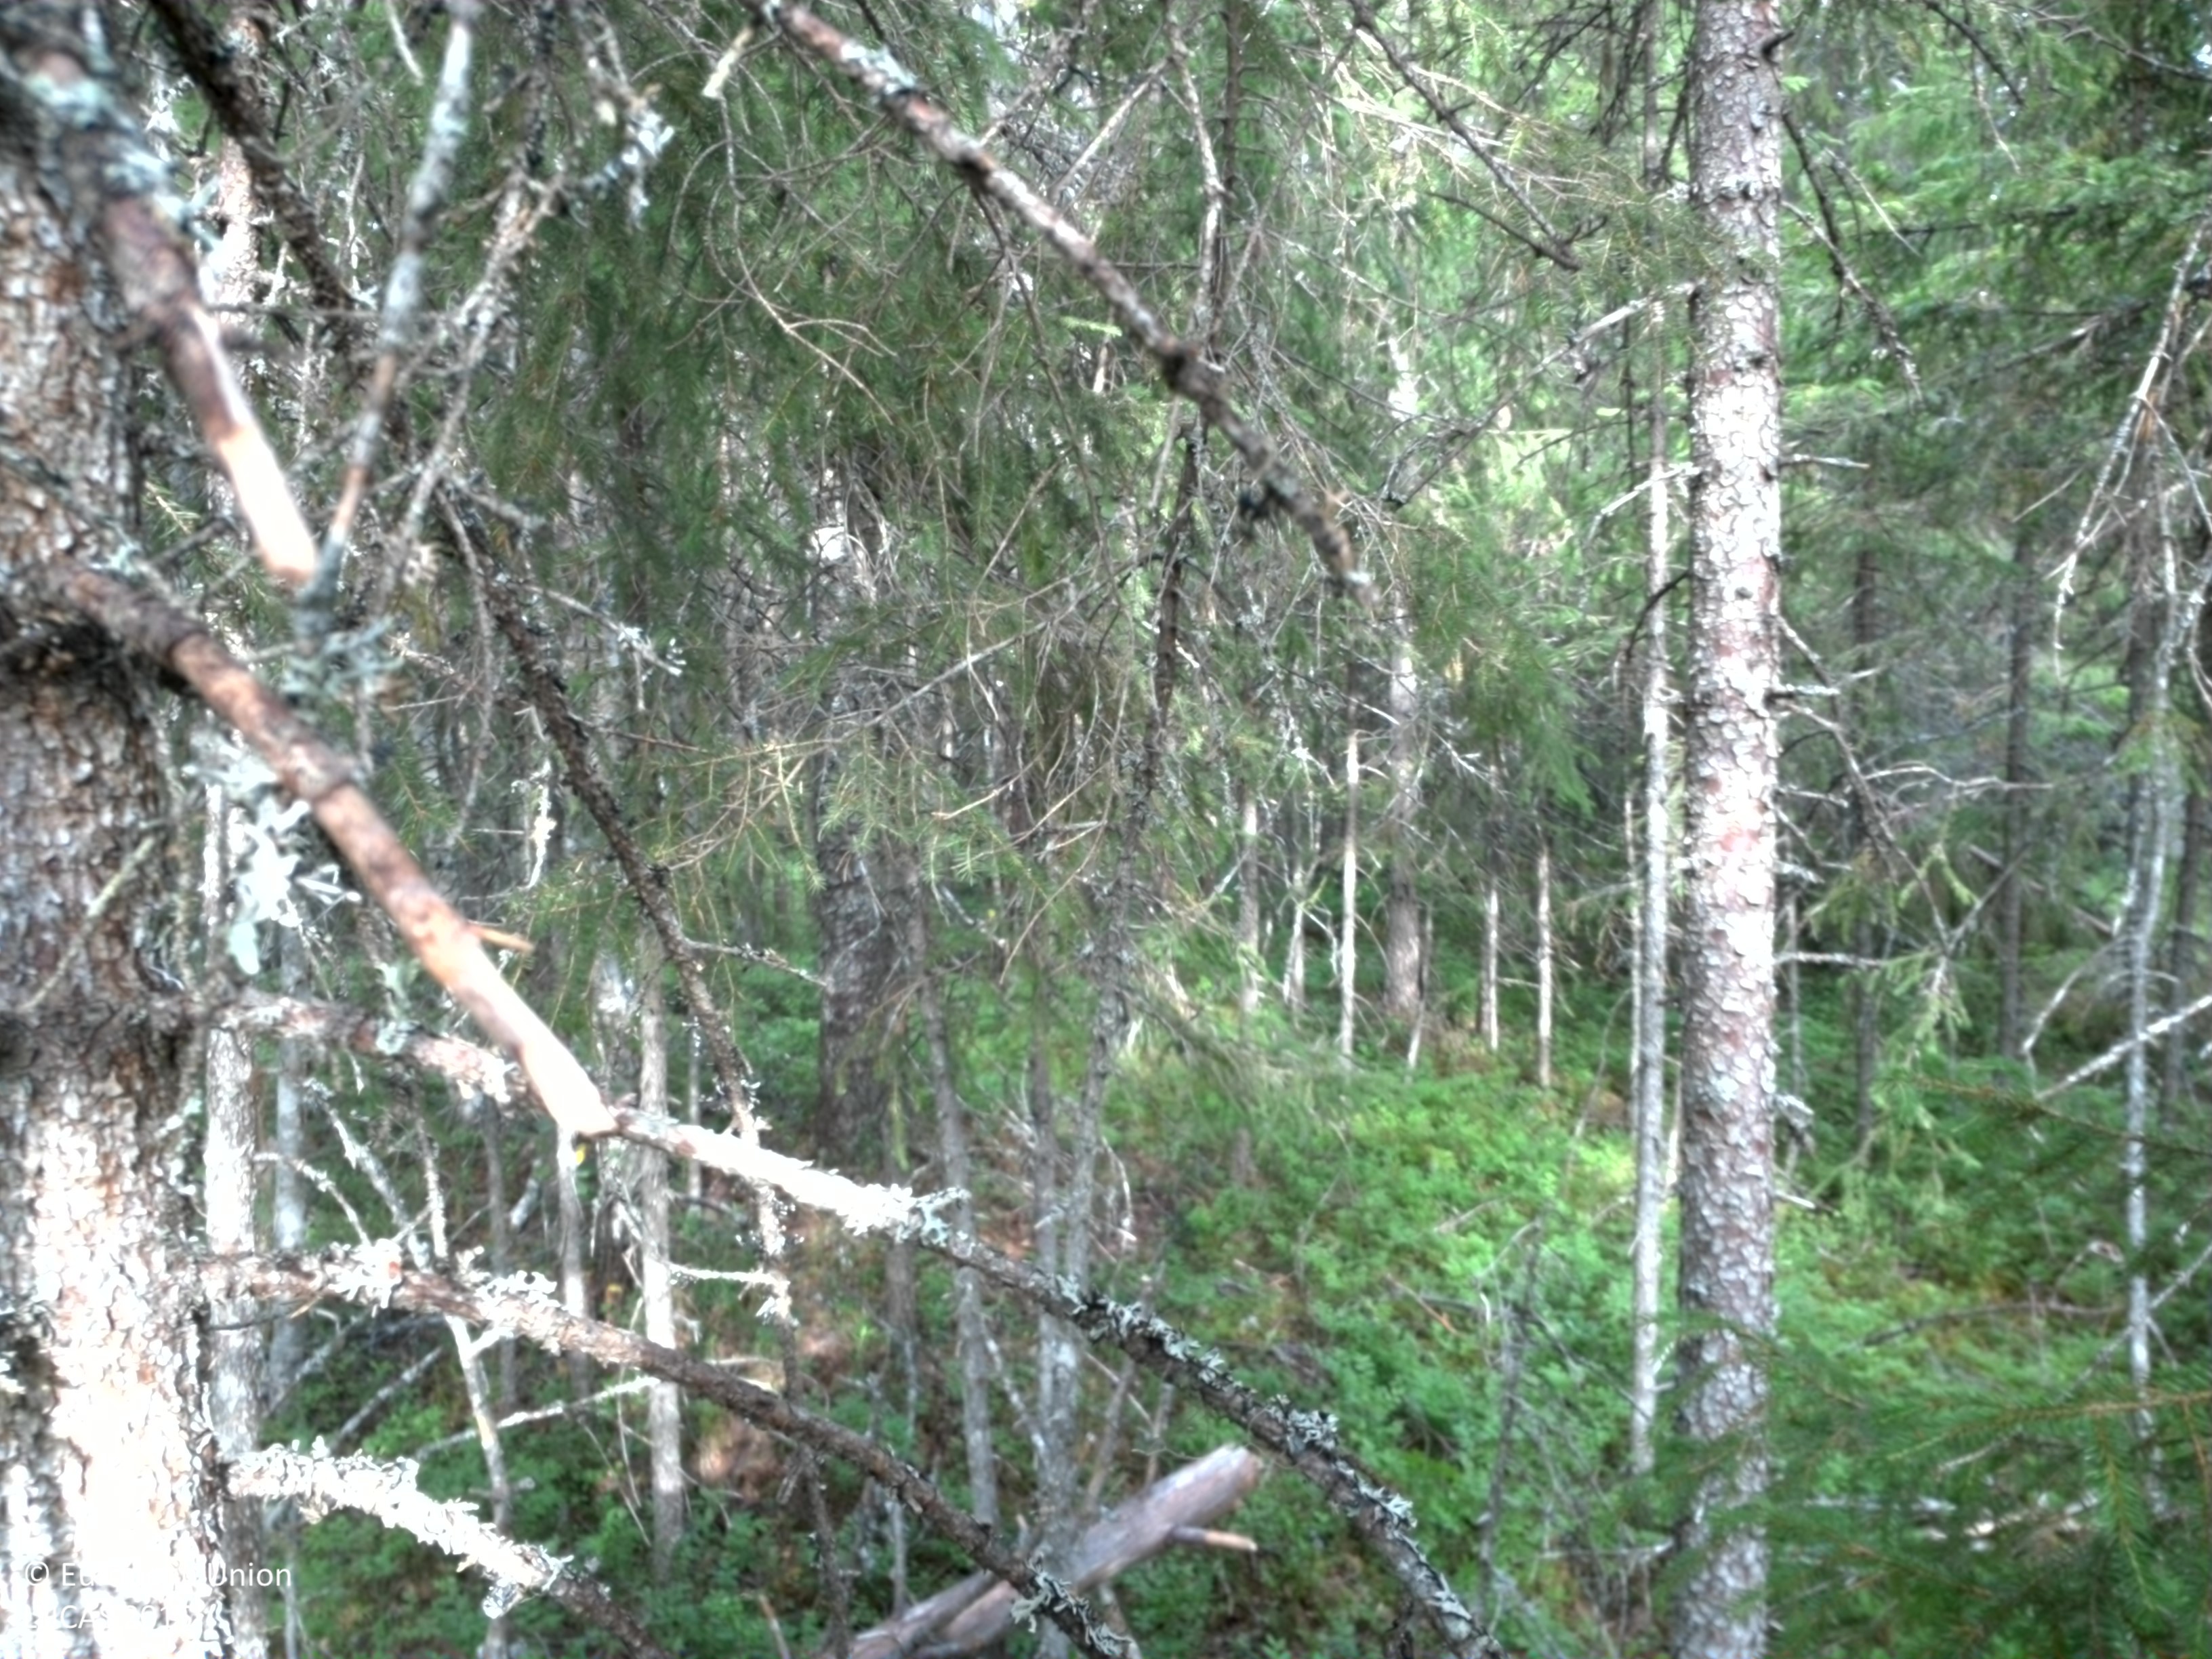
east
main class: Woodland
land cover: Other coniferous woodland
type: boreal forest
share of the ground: 50 - 75 %
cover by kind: coniferous forest trees 60 %, shrubs 35 %, lichens and mosses 5 %
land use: Forestry
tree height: > 5 m
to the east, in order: Other coniferous woodland; Spruce dominated coniferous woodland; Spruce dominated mixed woodland; Pine dominated mixed woodland; Pine dominated coniferous woodland; Spruce dominated mixed woodland; Pine dominated coniferous woodland
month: August
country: SE
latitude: 64.8246
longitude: 16.0977
